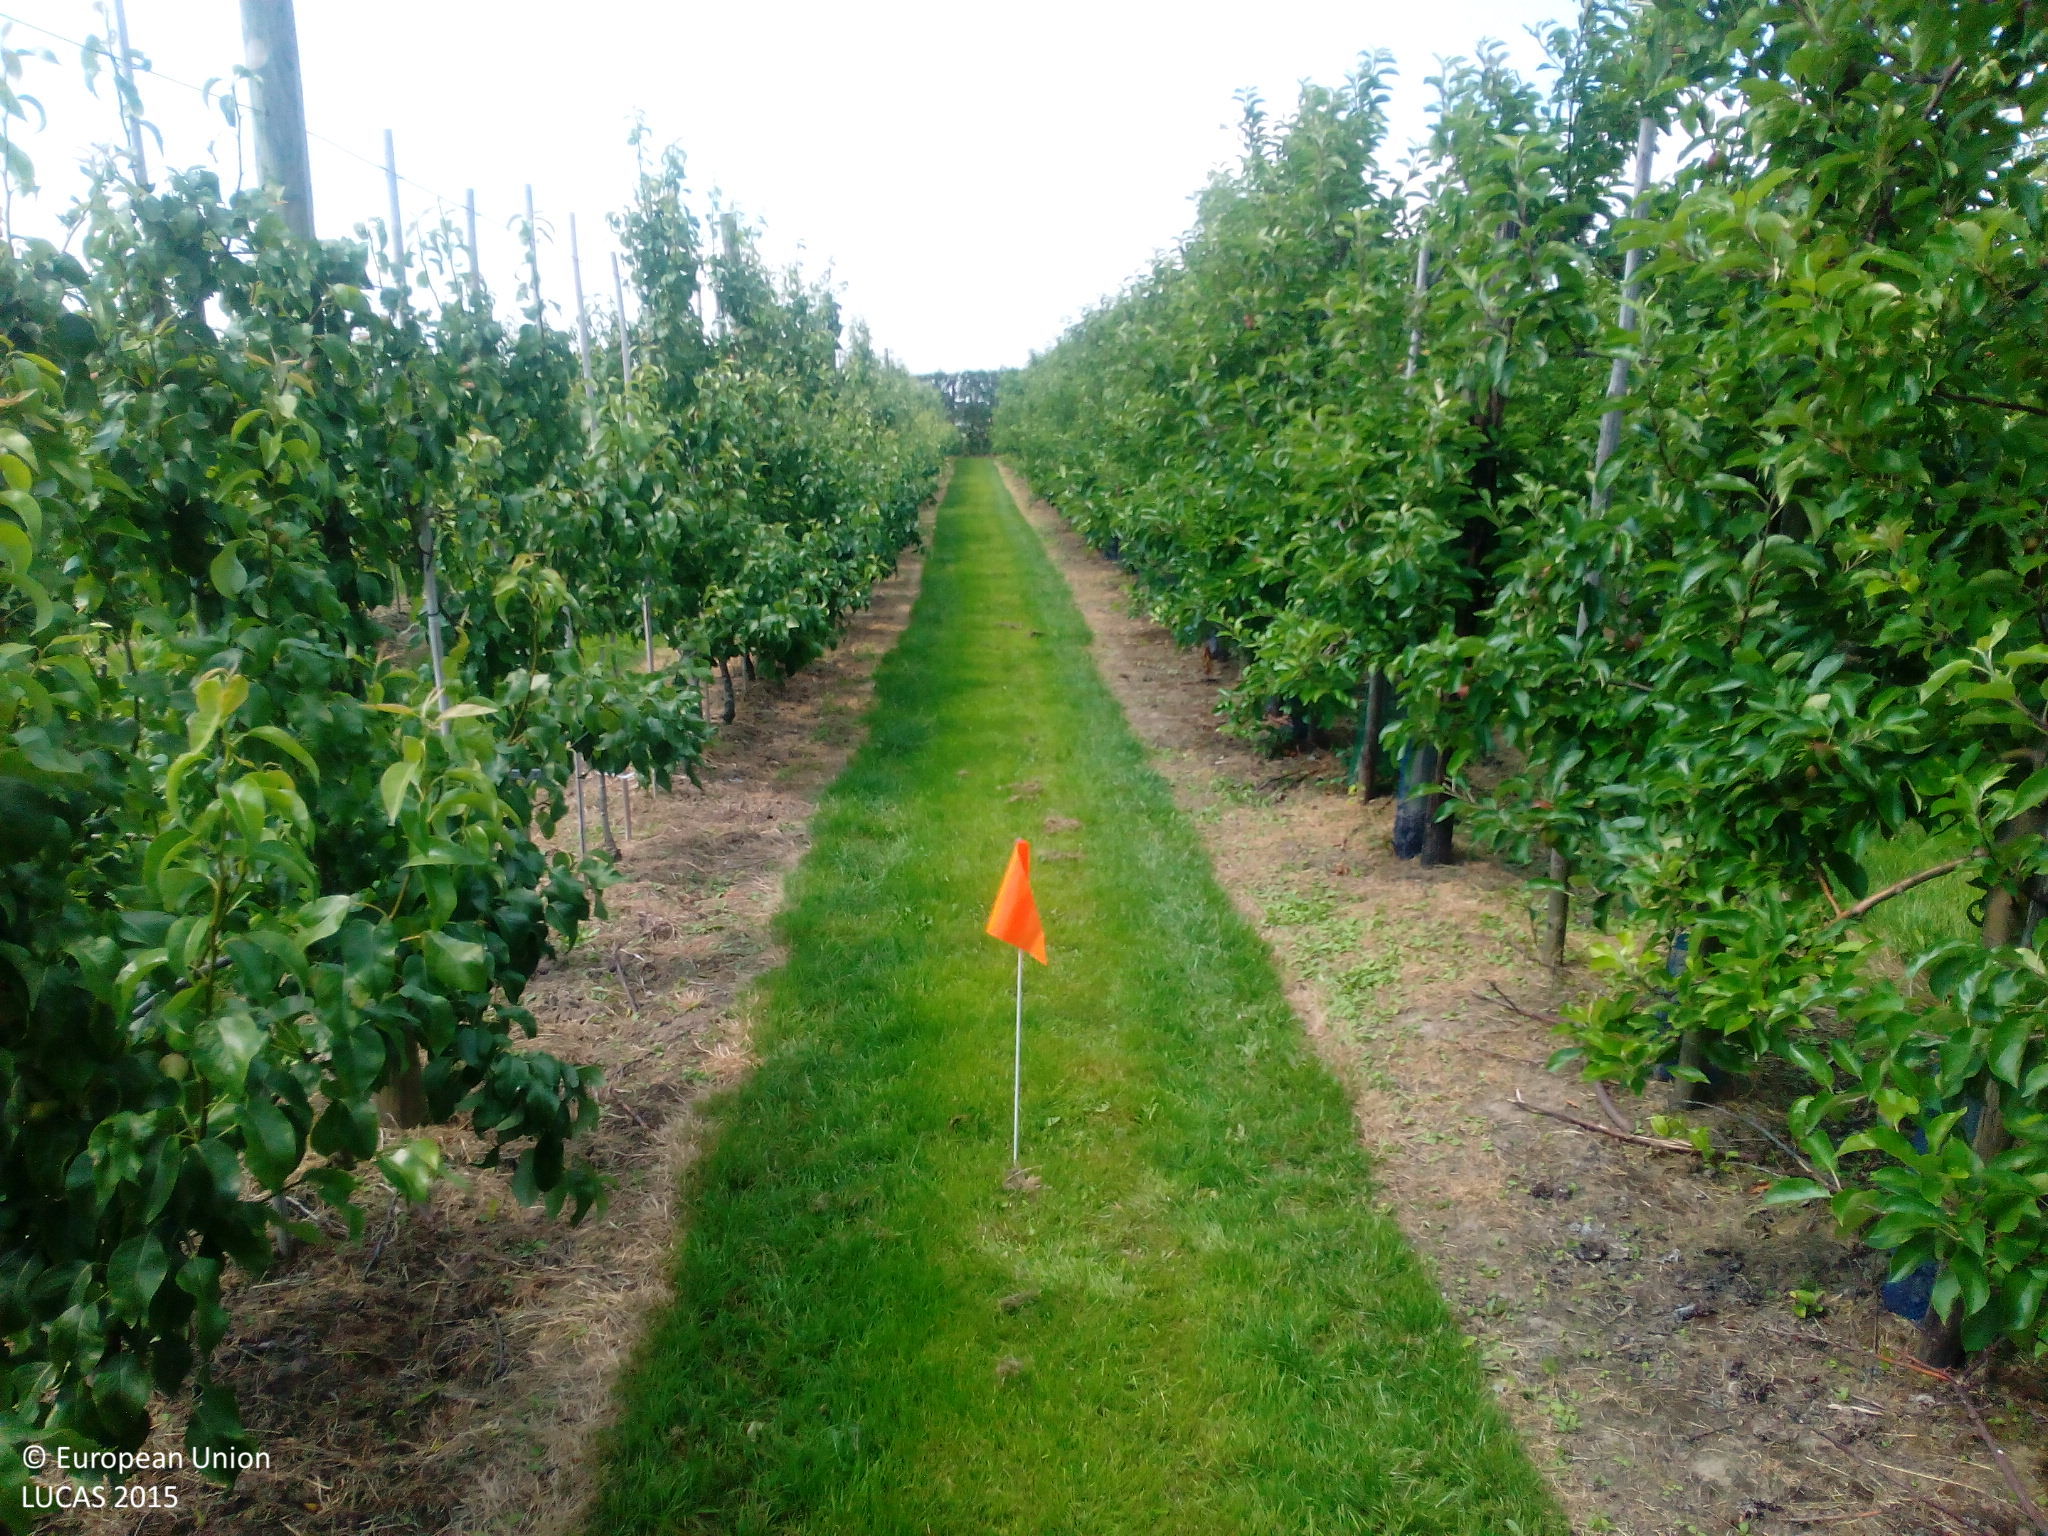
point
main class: Cropland
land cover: Pear fruit
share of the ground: 50 - 75 %
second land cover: Grassland without tree/shrub cover
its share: 25 - 50 %
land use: Agriculture (excluding fallow land and kitchen gardens)
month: June
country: NL
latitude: 51.6642
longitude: 4.6904
